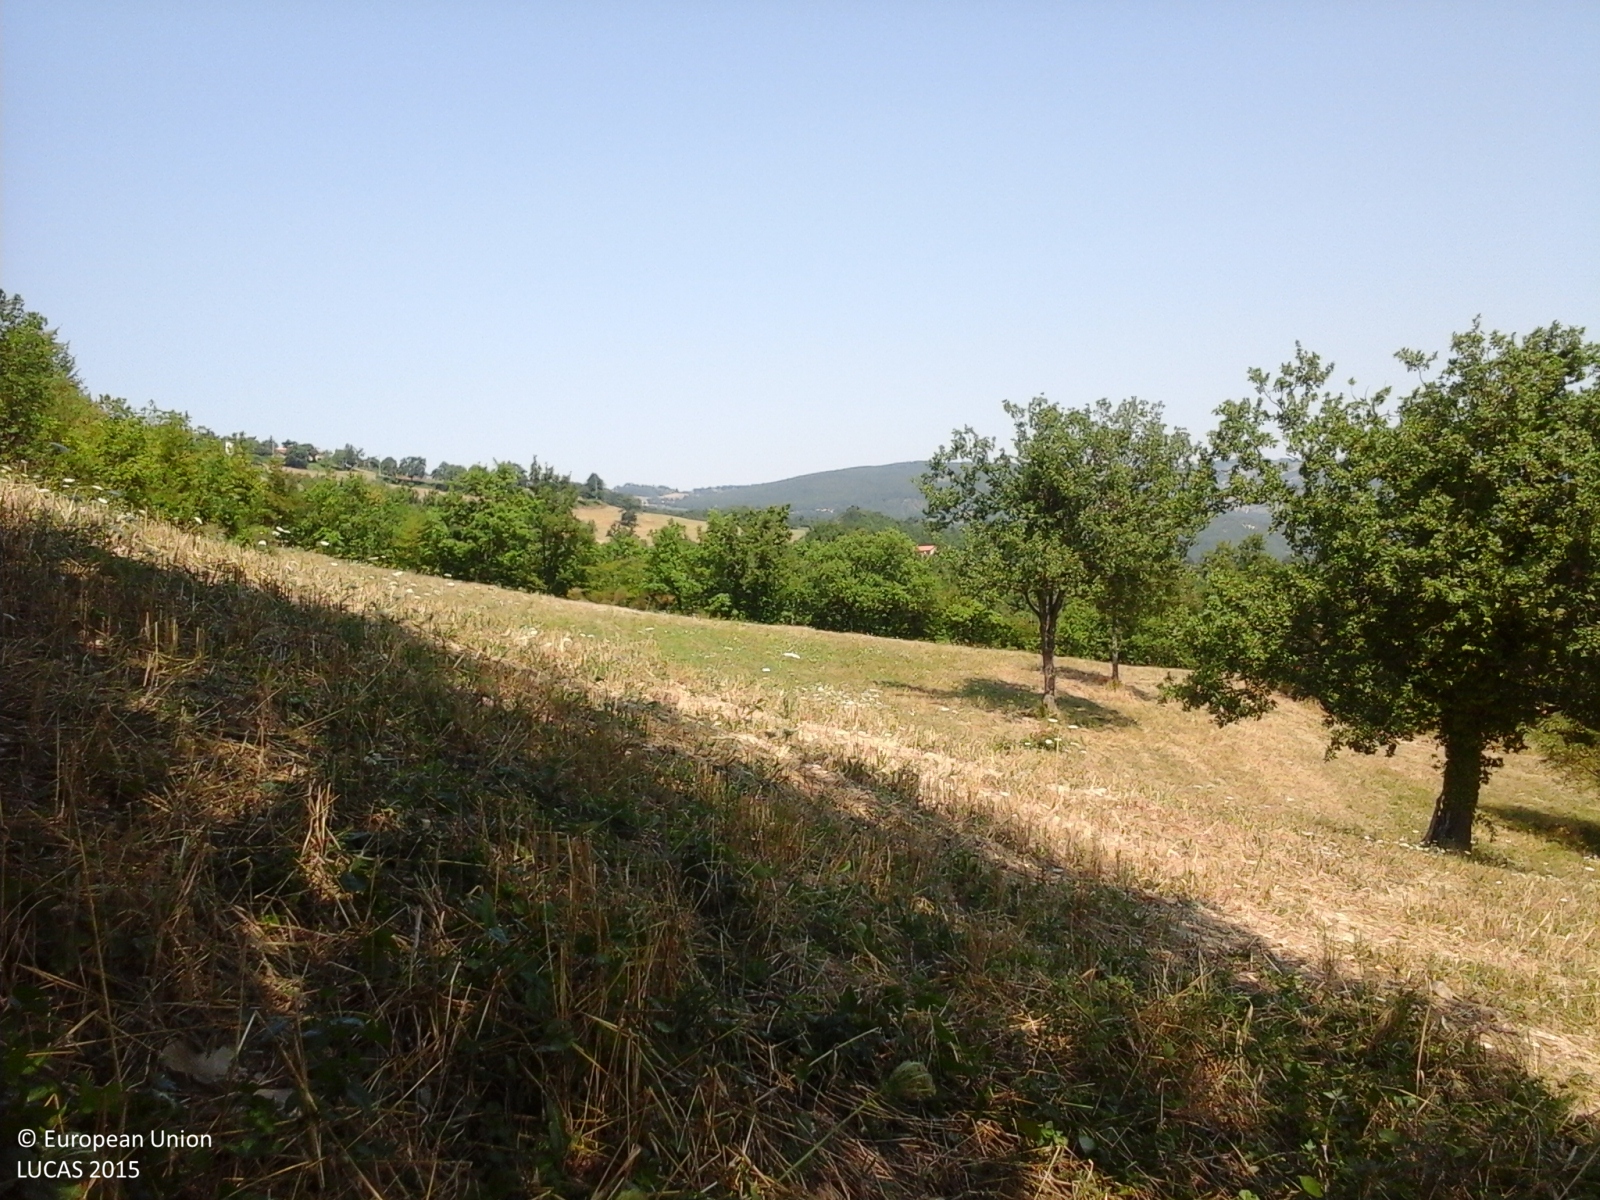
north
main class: Woodland
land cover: Broadleaved woodland
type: thermophilous deciduous forest
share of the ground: > 75 %
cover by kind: broadleaved forest trees 100 %
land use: Forestry
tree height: > 5 m
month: August
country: IT
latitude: 43.6942
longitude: 12.2648
